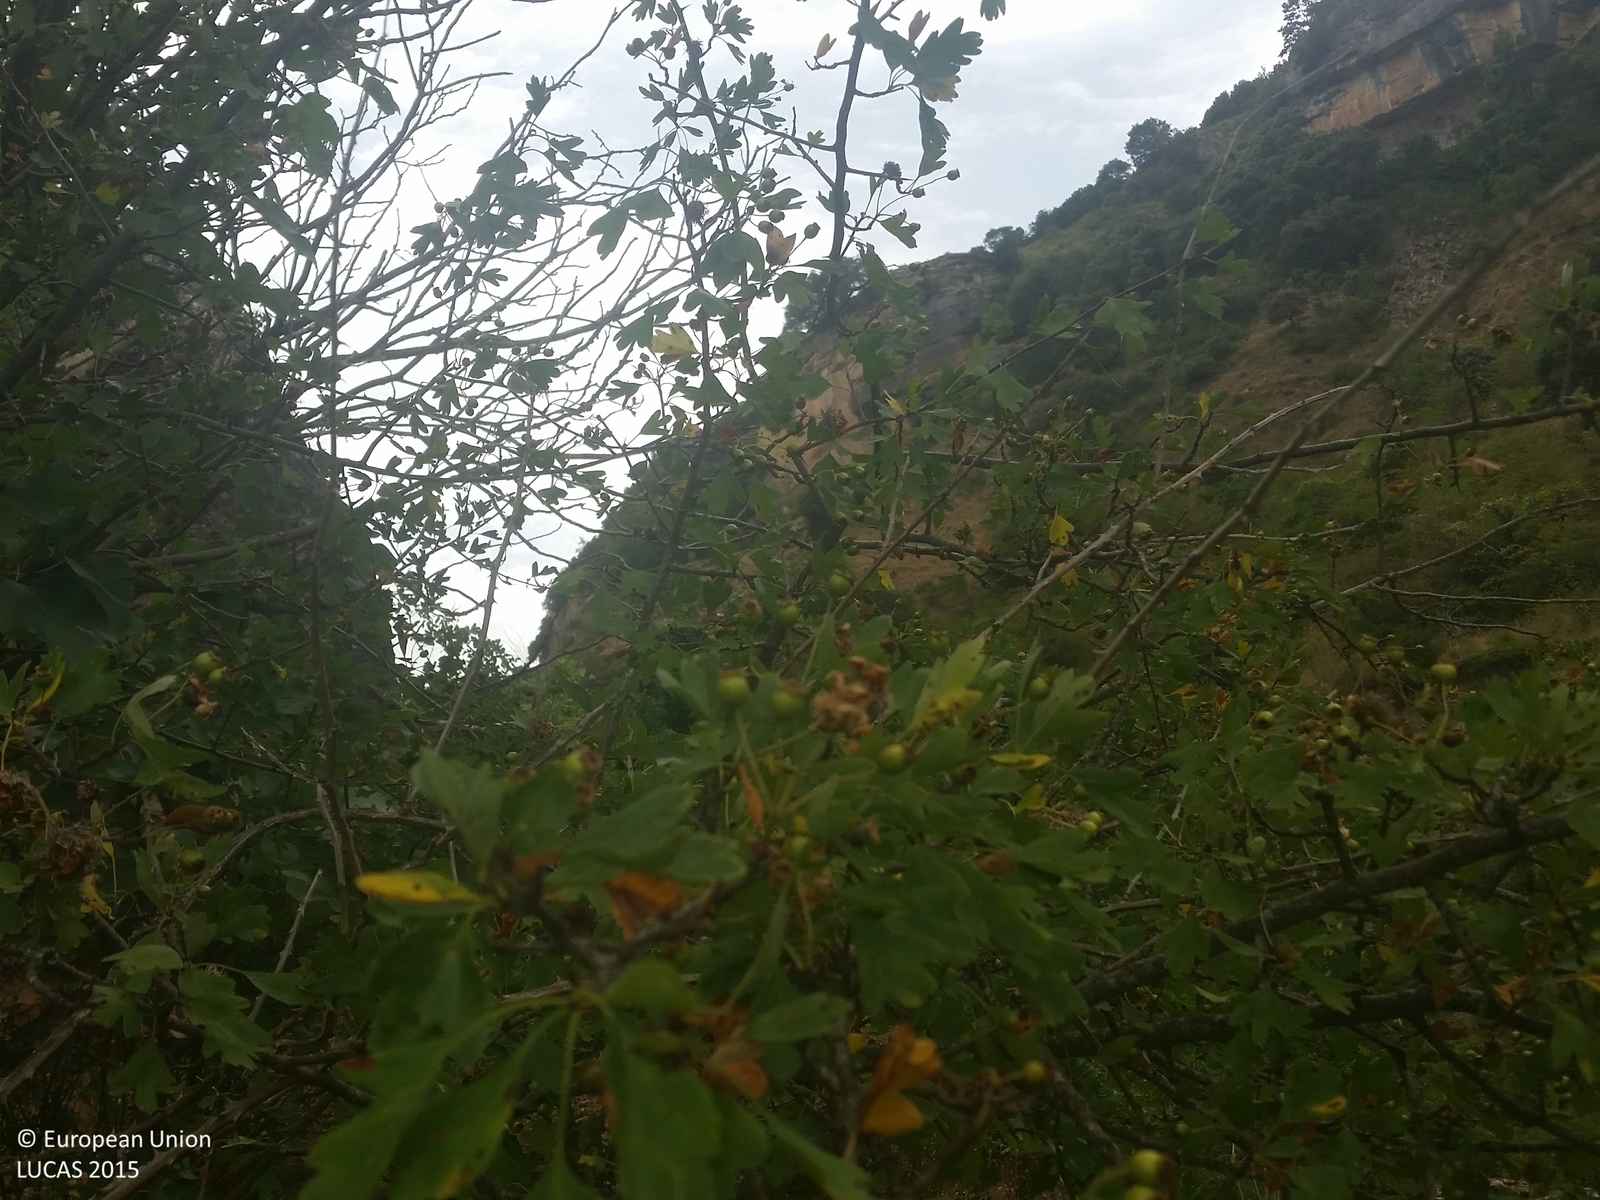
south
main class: Shrubland
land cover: Shrubland without tree cover
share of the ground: > 75 %
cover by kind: shrubs 100 %
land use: Semi-natural and natural areas not in use
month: August
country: ES
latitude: 38.6455
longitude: -2.4669
